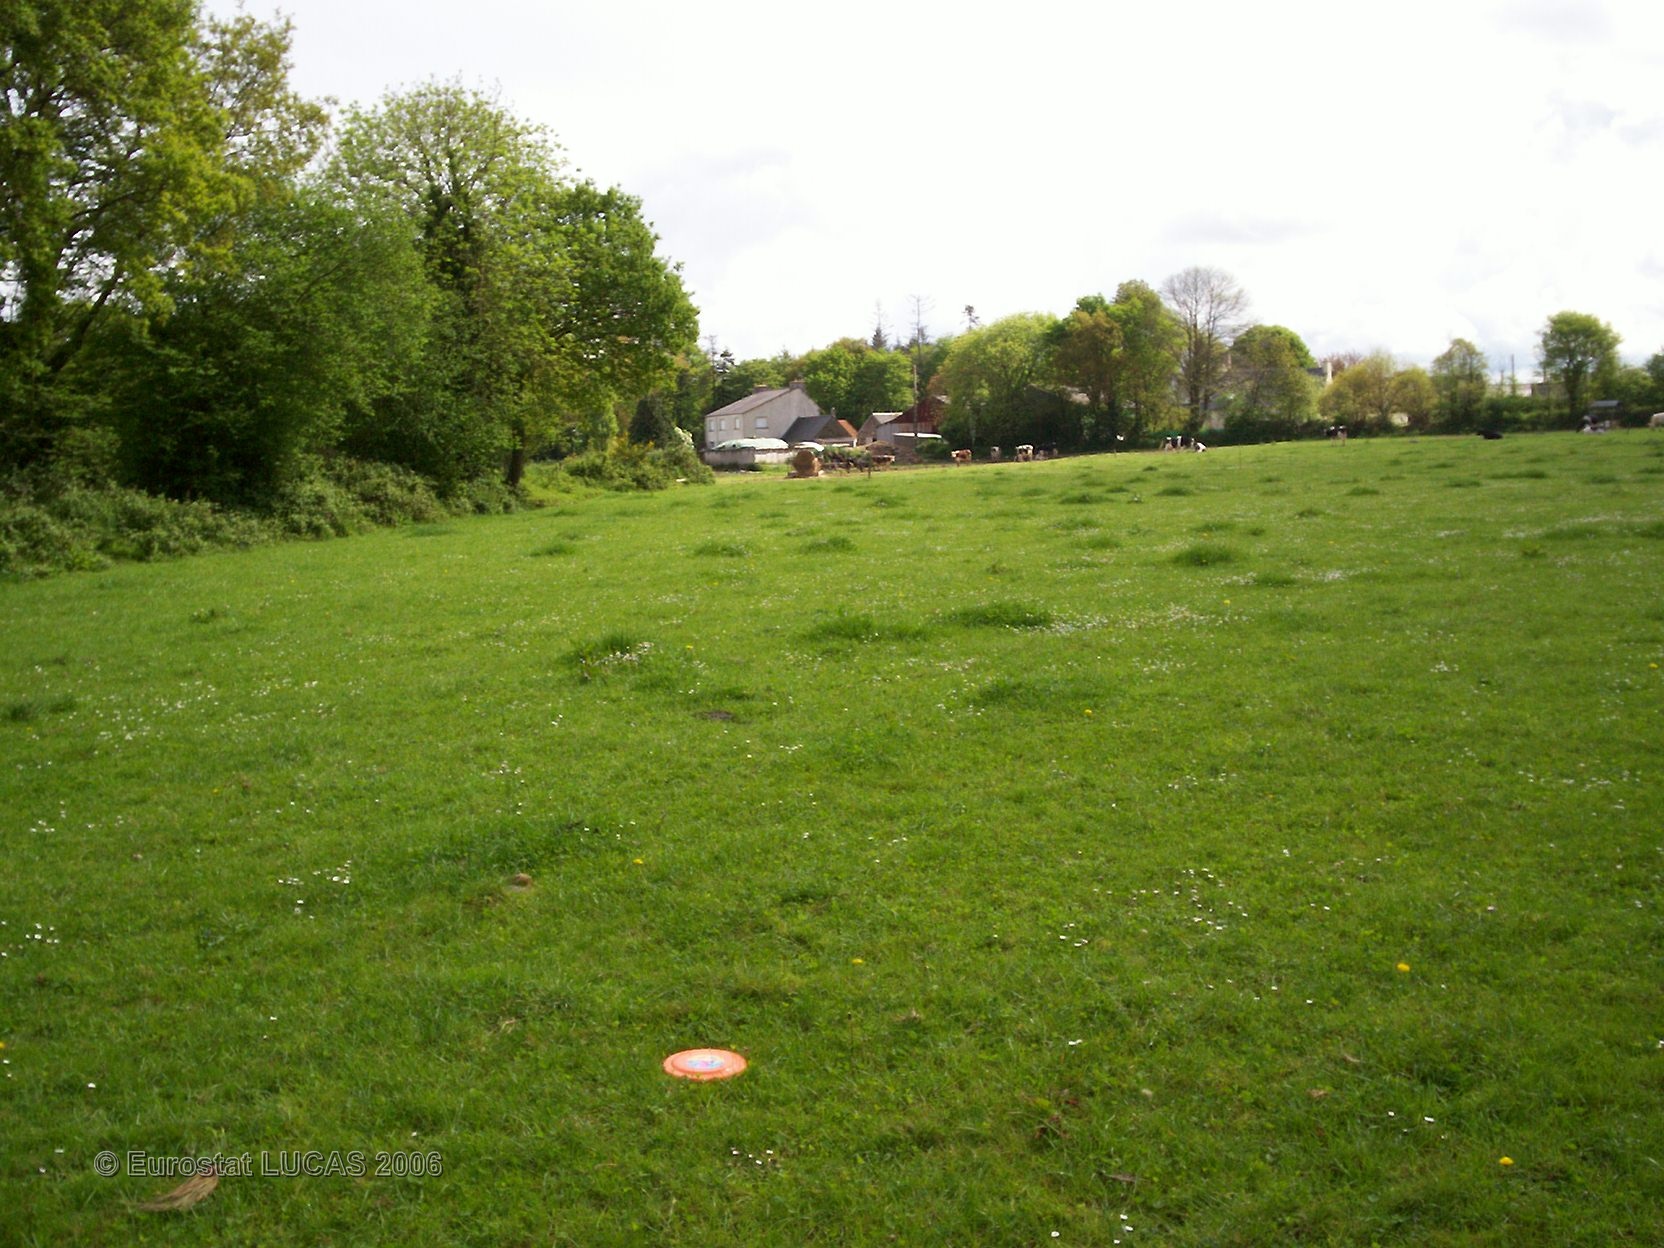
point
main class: Grassland
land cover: Grassland without tree/shrub cover
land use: Agriculture (excluding fallow land and kitchen gardens)
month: May
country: FR
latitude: 48.5749
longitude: -3.7875
